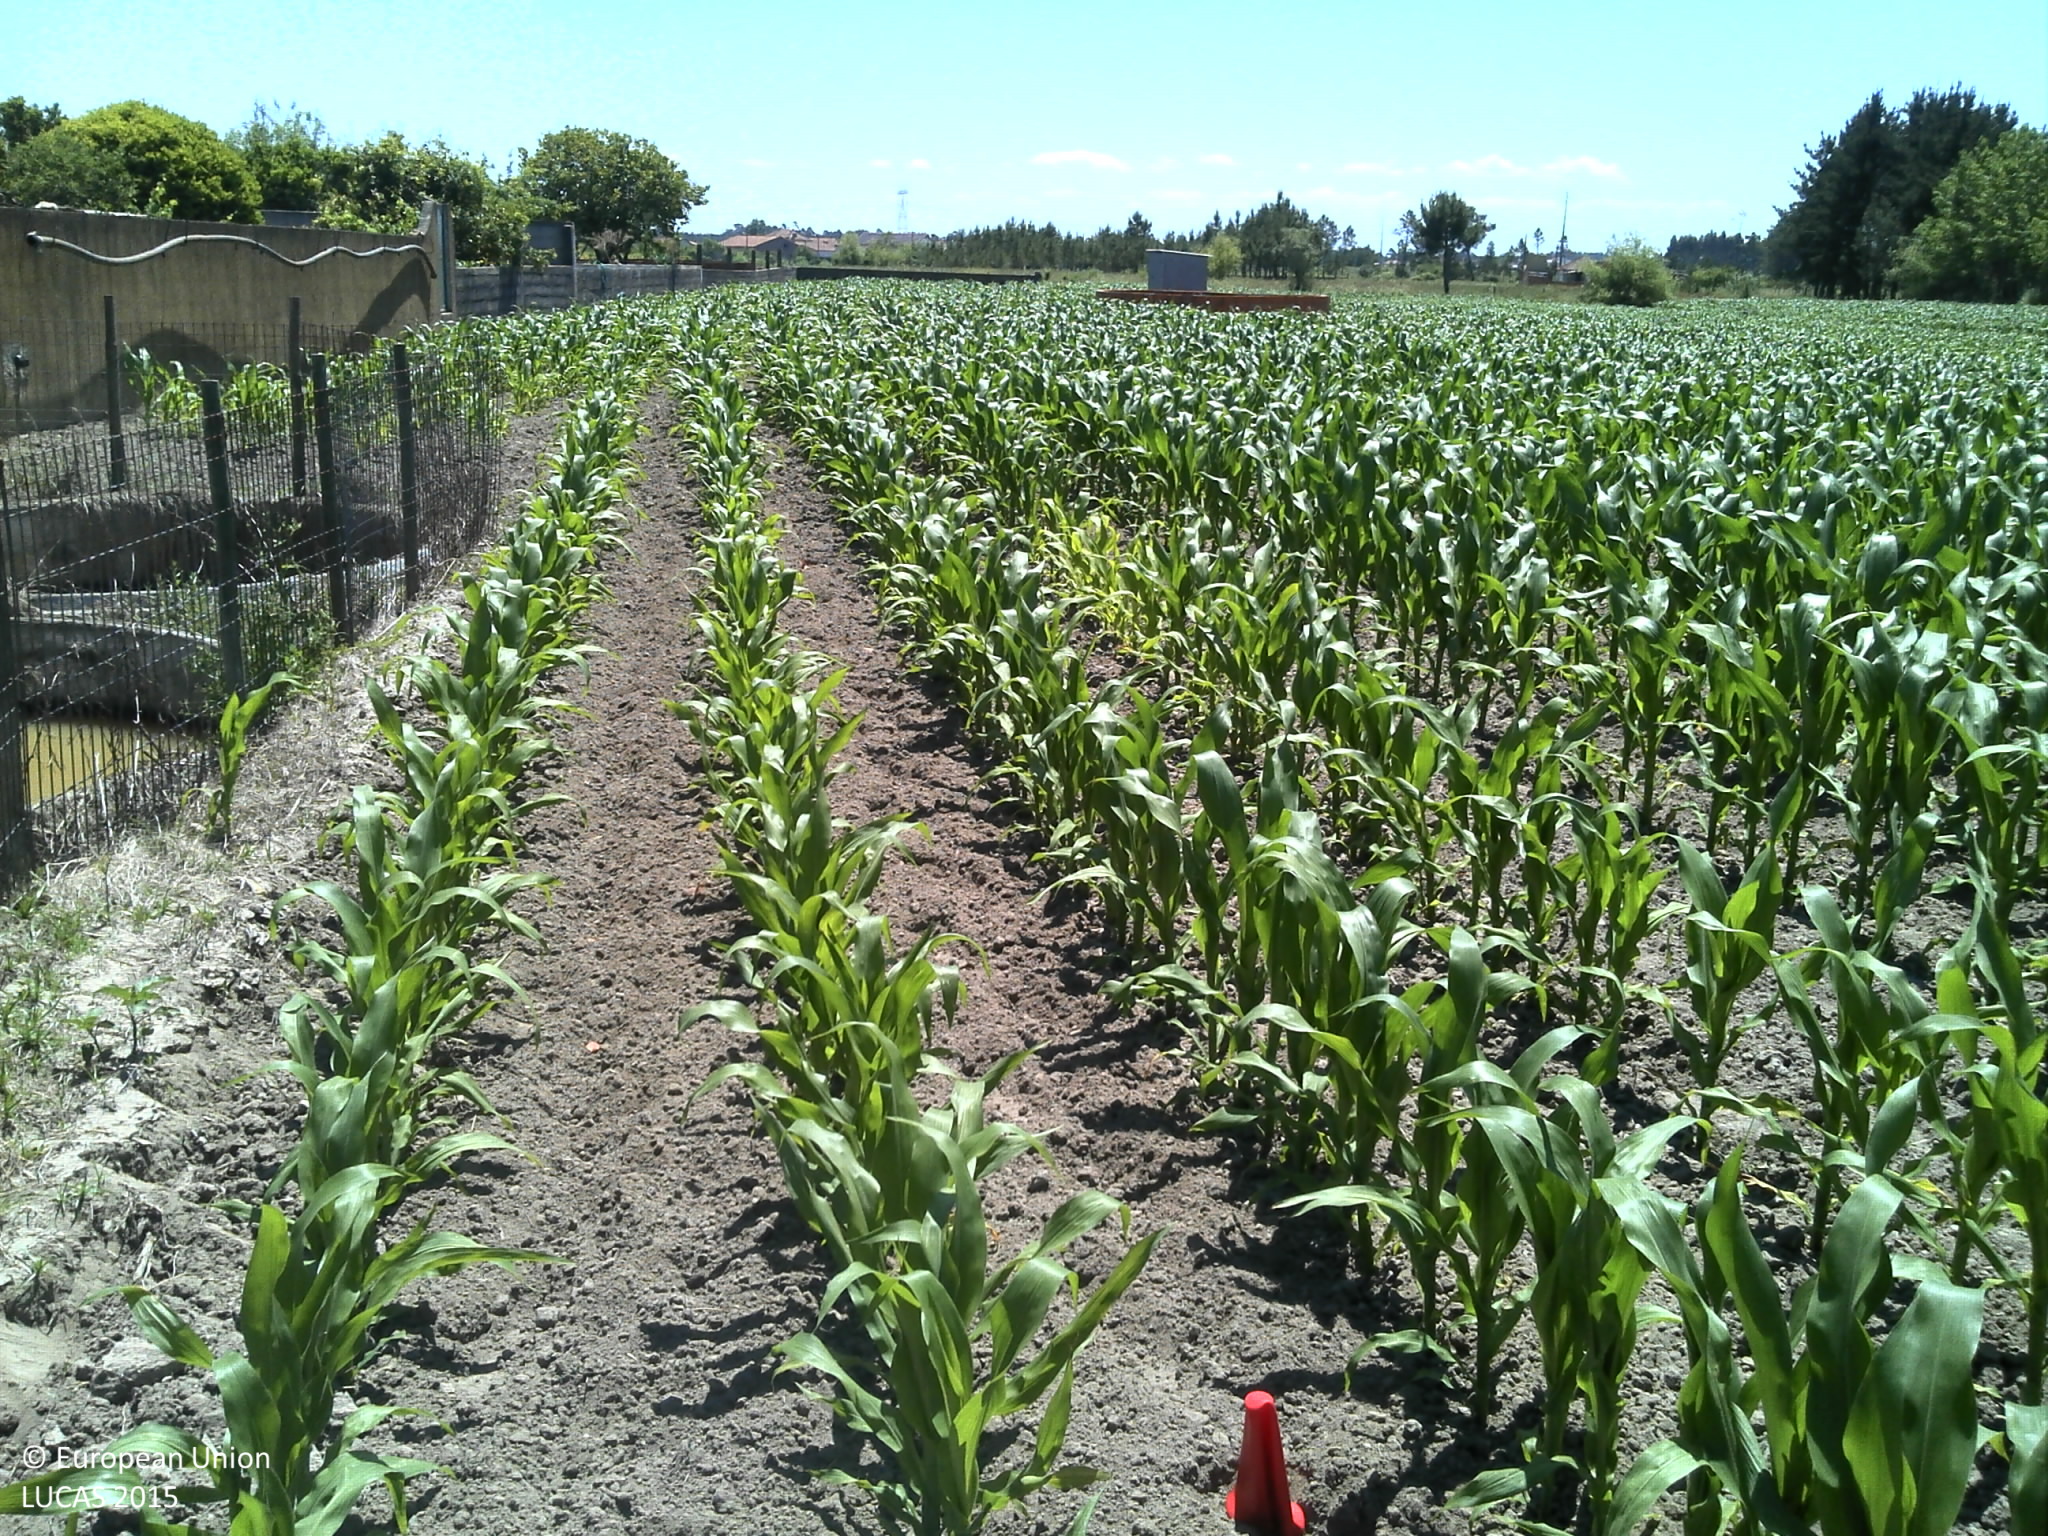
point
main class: Cropland
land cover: Maize
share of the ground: 10 - 25 %
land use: Agriculture (excluding fallow land and kitchen gardens)
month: May
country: PT
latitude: 40.4651
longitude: -8.6214
